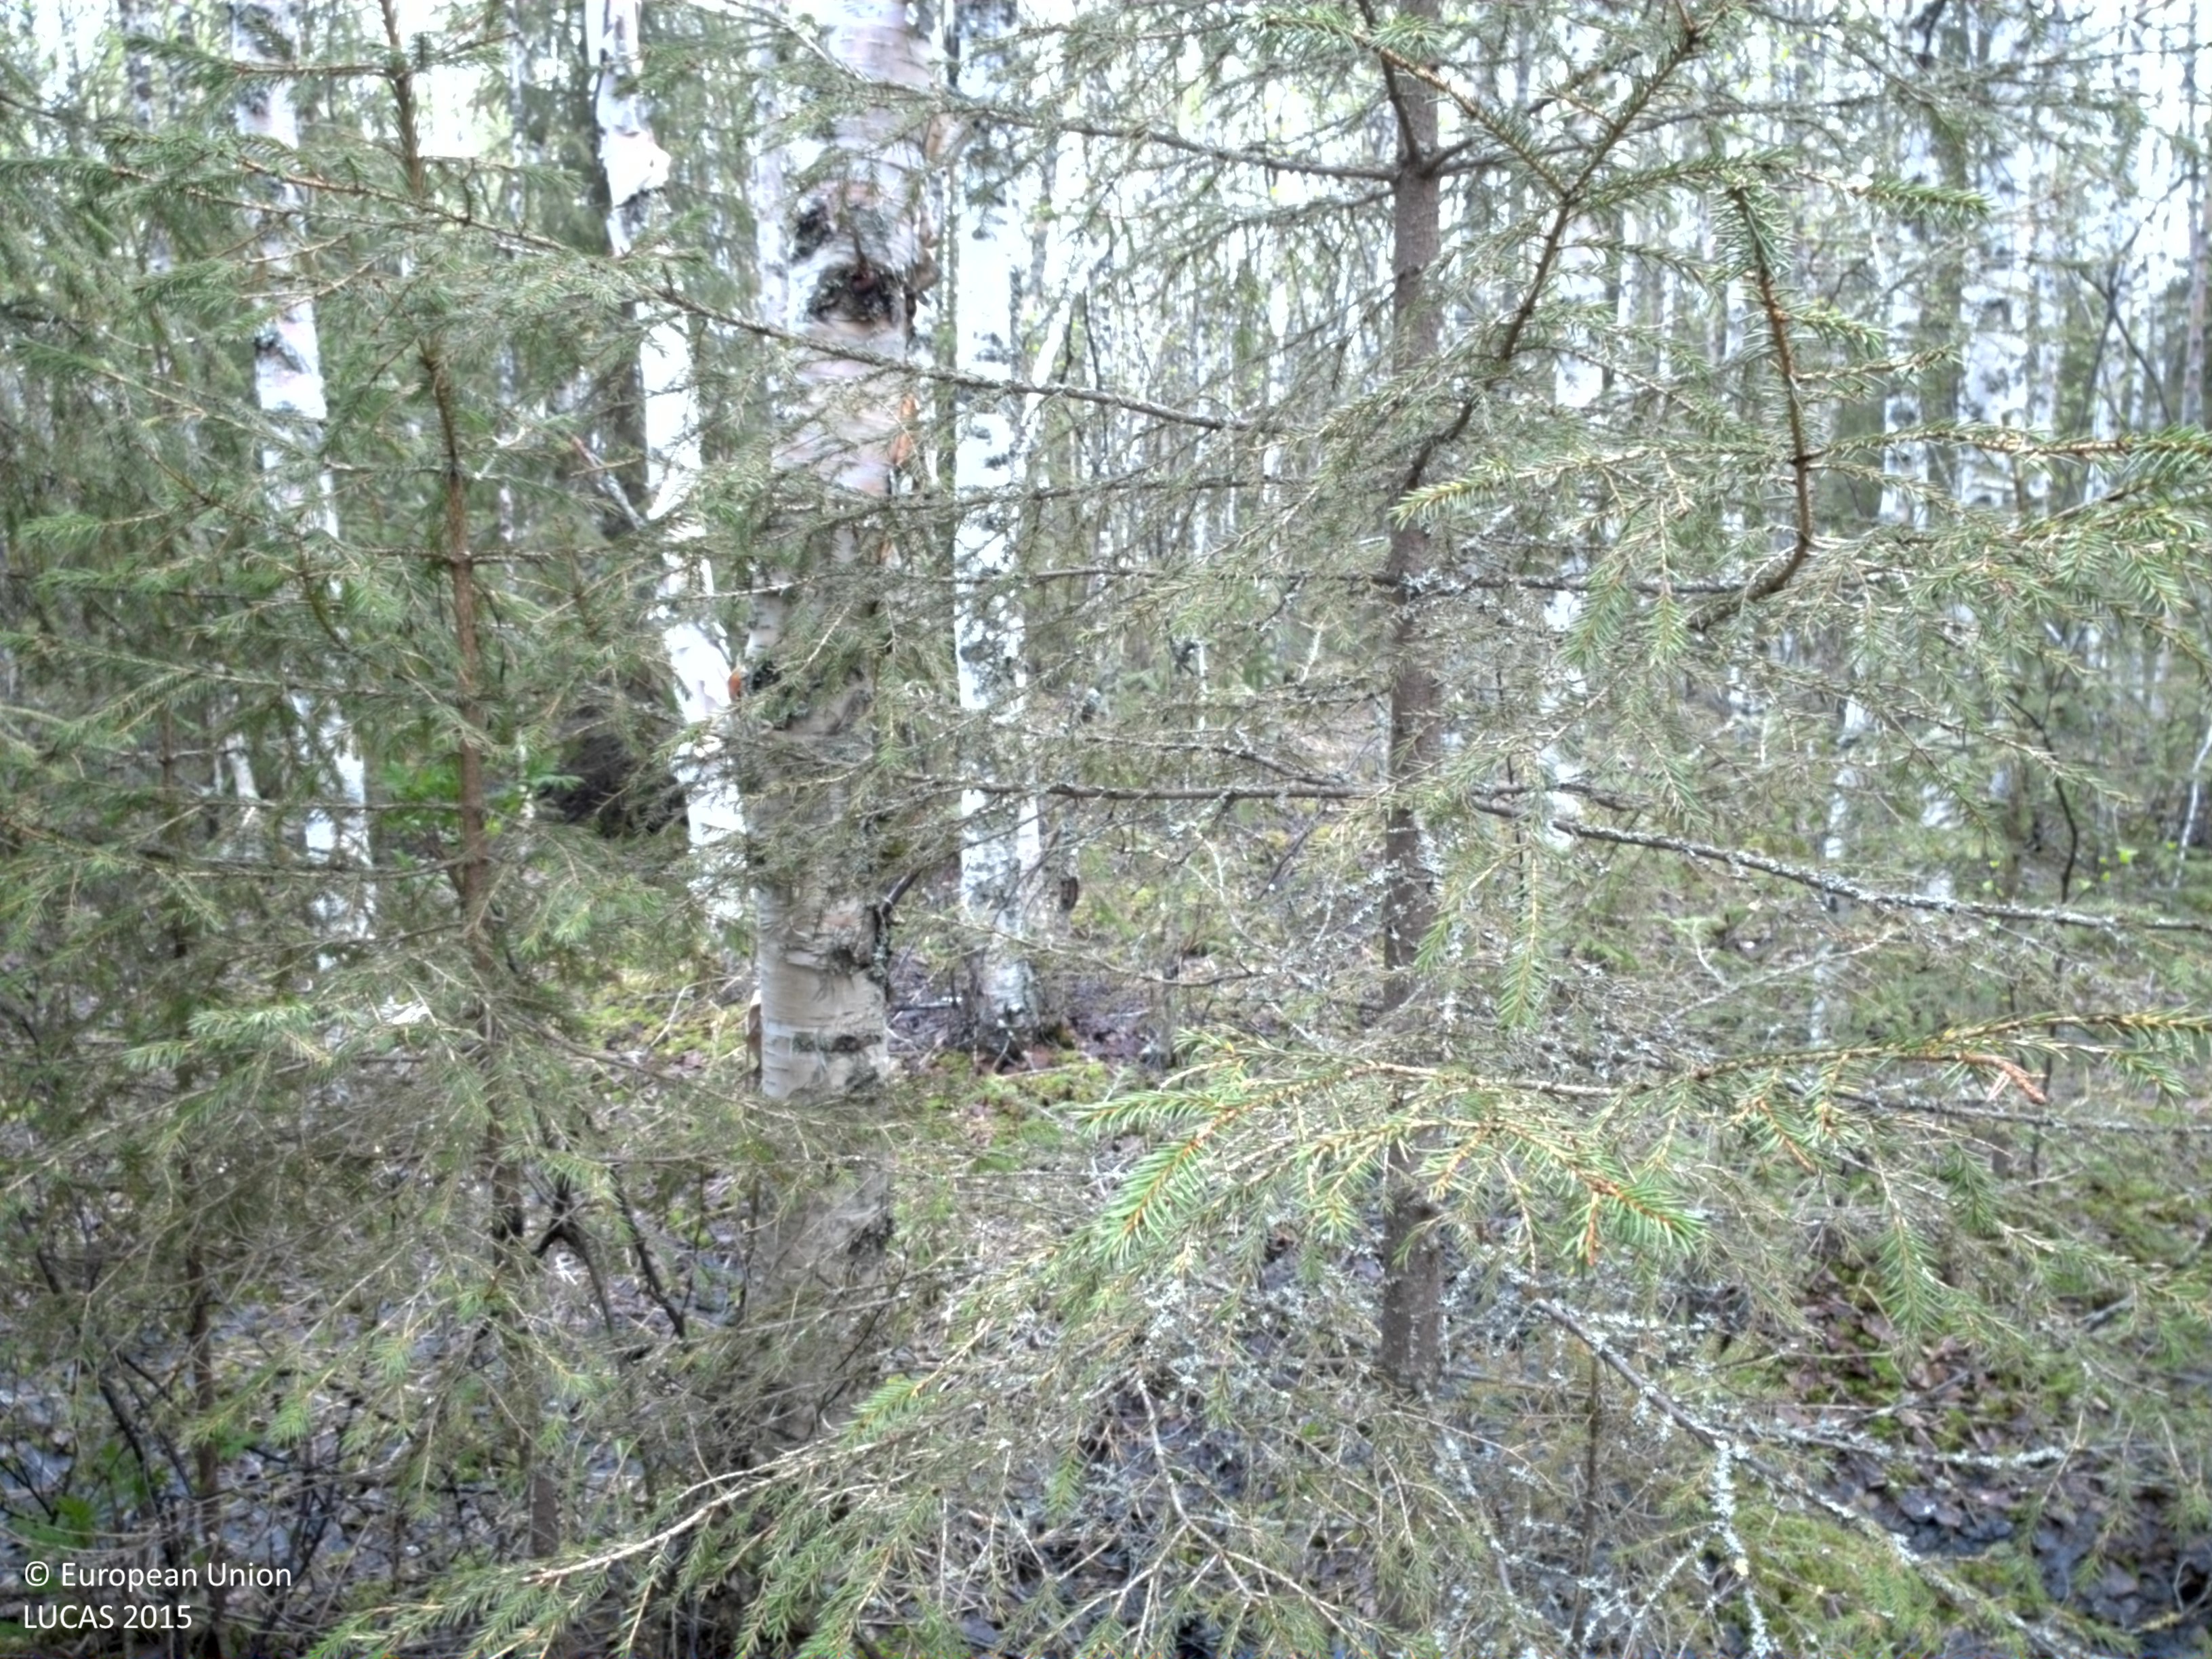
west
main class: Woodland
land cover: Broadleaved woodland
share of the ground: > 75 %
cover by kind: broadleaved forest trees 75 %, coniferous forest trees 10 %, lichens and mosses 10 %, herbaceous plants 5 %
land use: Forestry
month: June
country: SE
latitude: 65.9327
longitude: 23.2840
